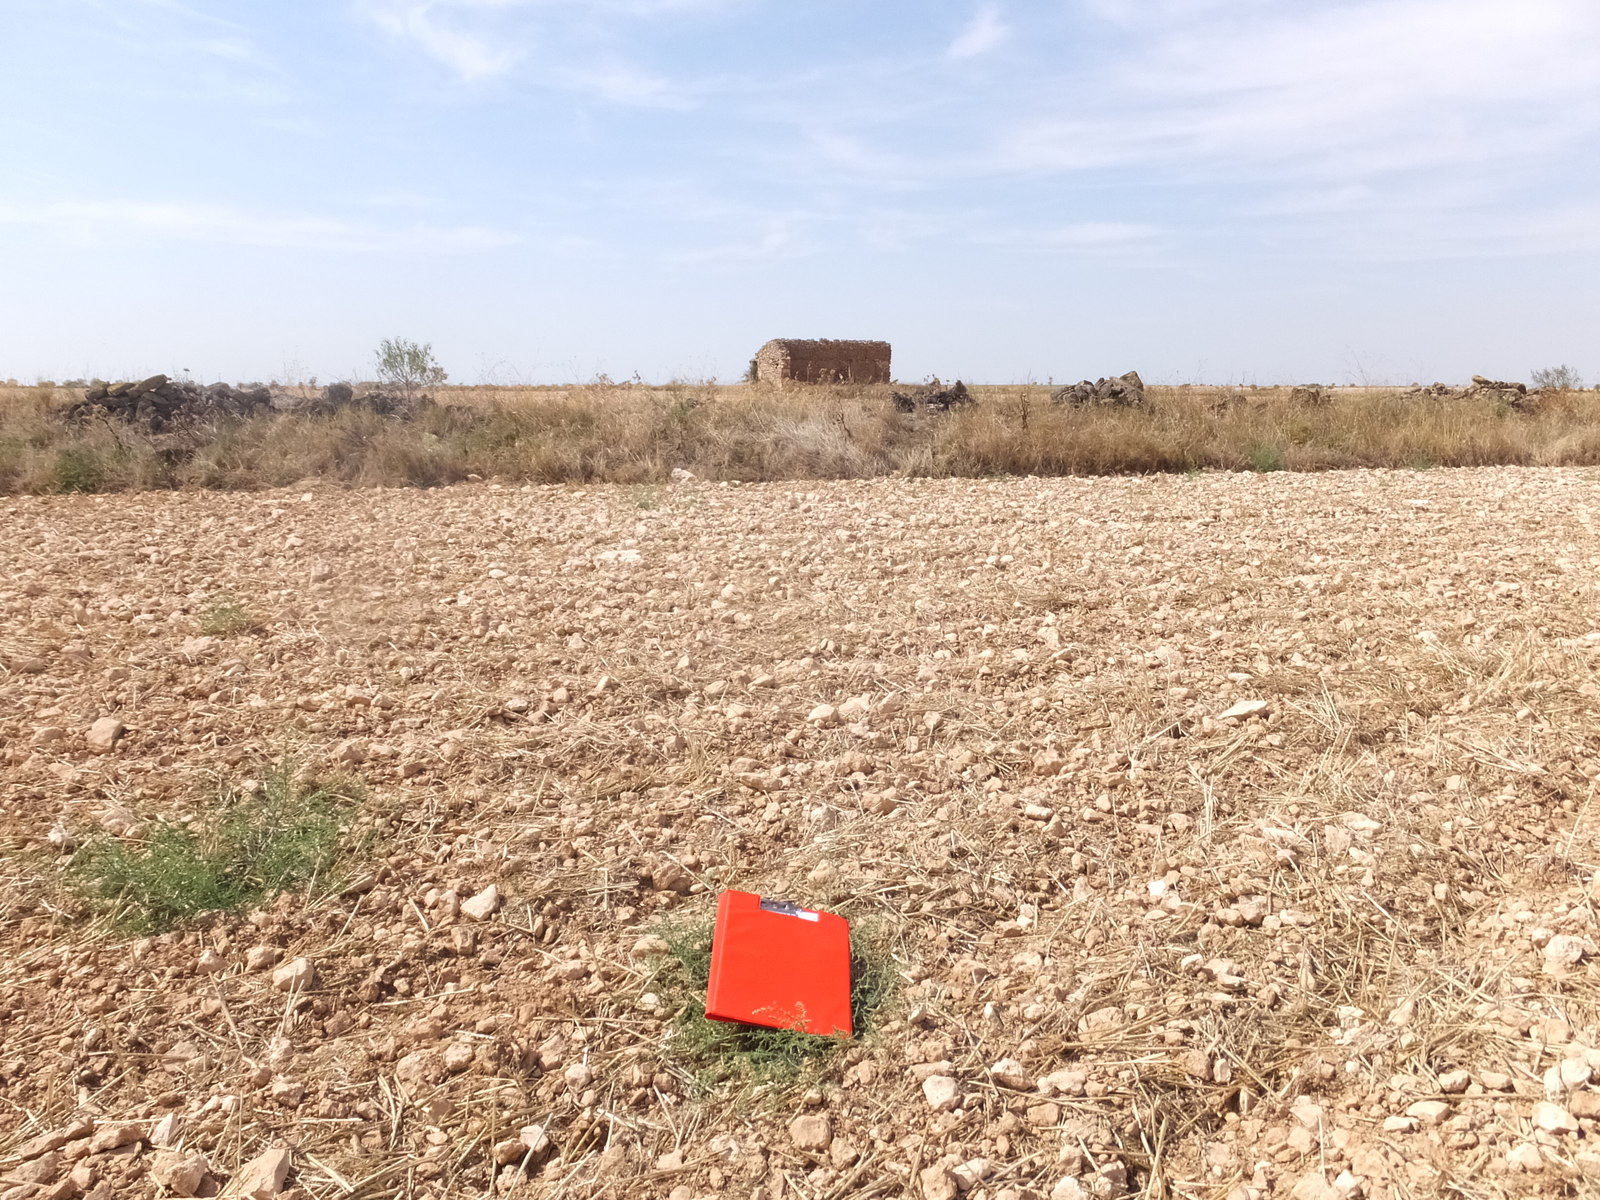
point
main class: Cropland
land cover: Common wheat
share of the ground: < 10 %
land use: Agriculture (excluding fallow land and kitchen gardens)
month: August
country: ES
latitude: 41.5296
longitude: 0.2668
